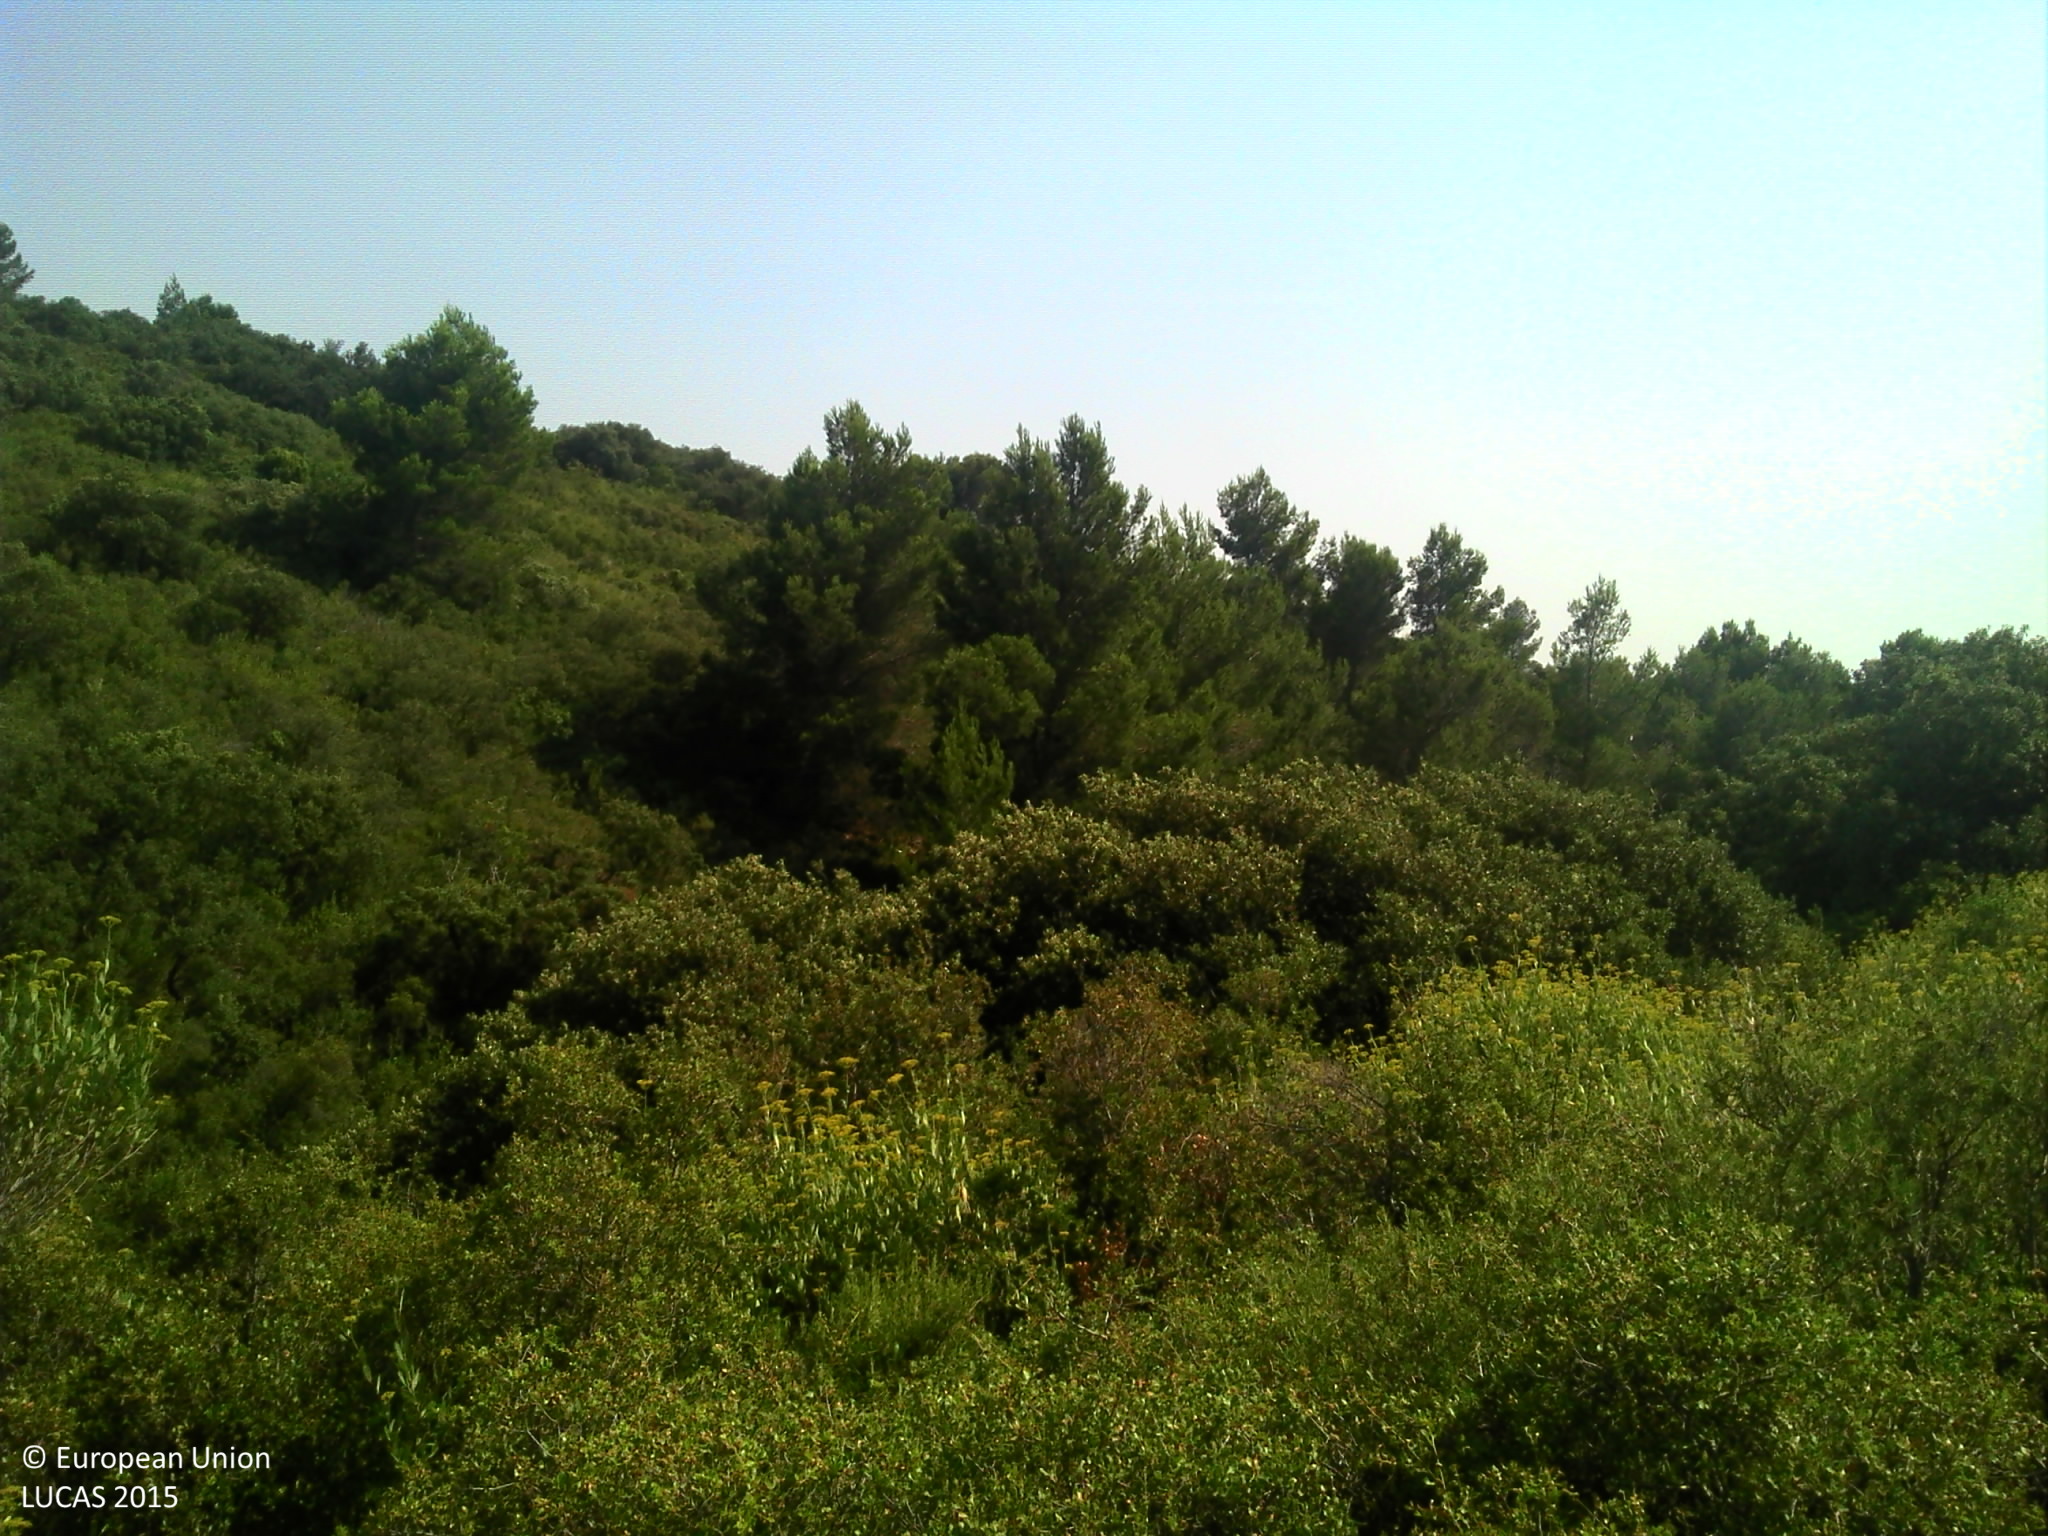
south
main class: Shrubland
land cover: Shrubland without tree cover
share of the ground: > 75 %
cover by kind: shrubs 75 %, herbaceous plants 25 %
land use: Semi-natural and natural areas not in use
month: July
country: FR
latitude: 43.7468
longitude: 4.7315
